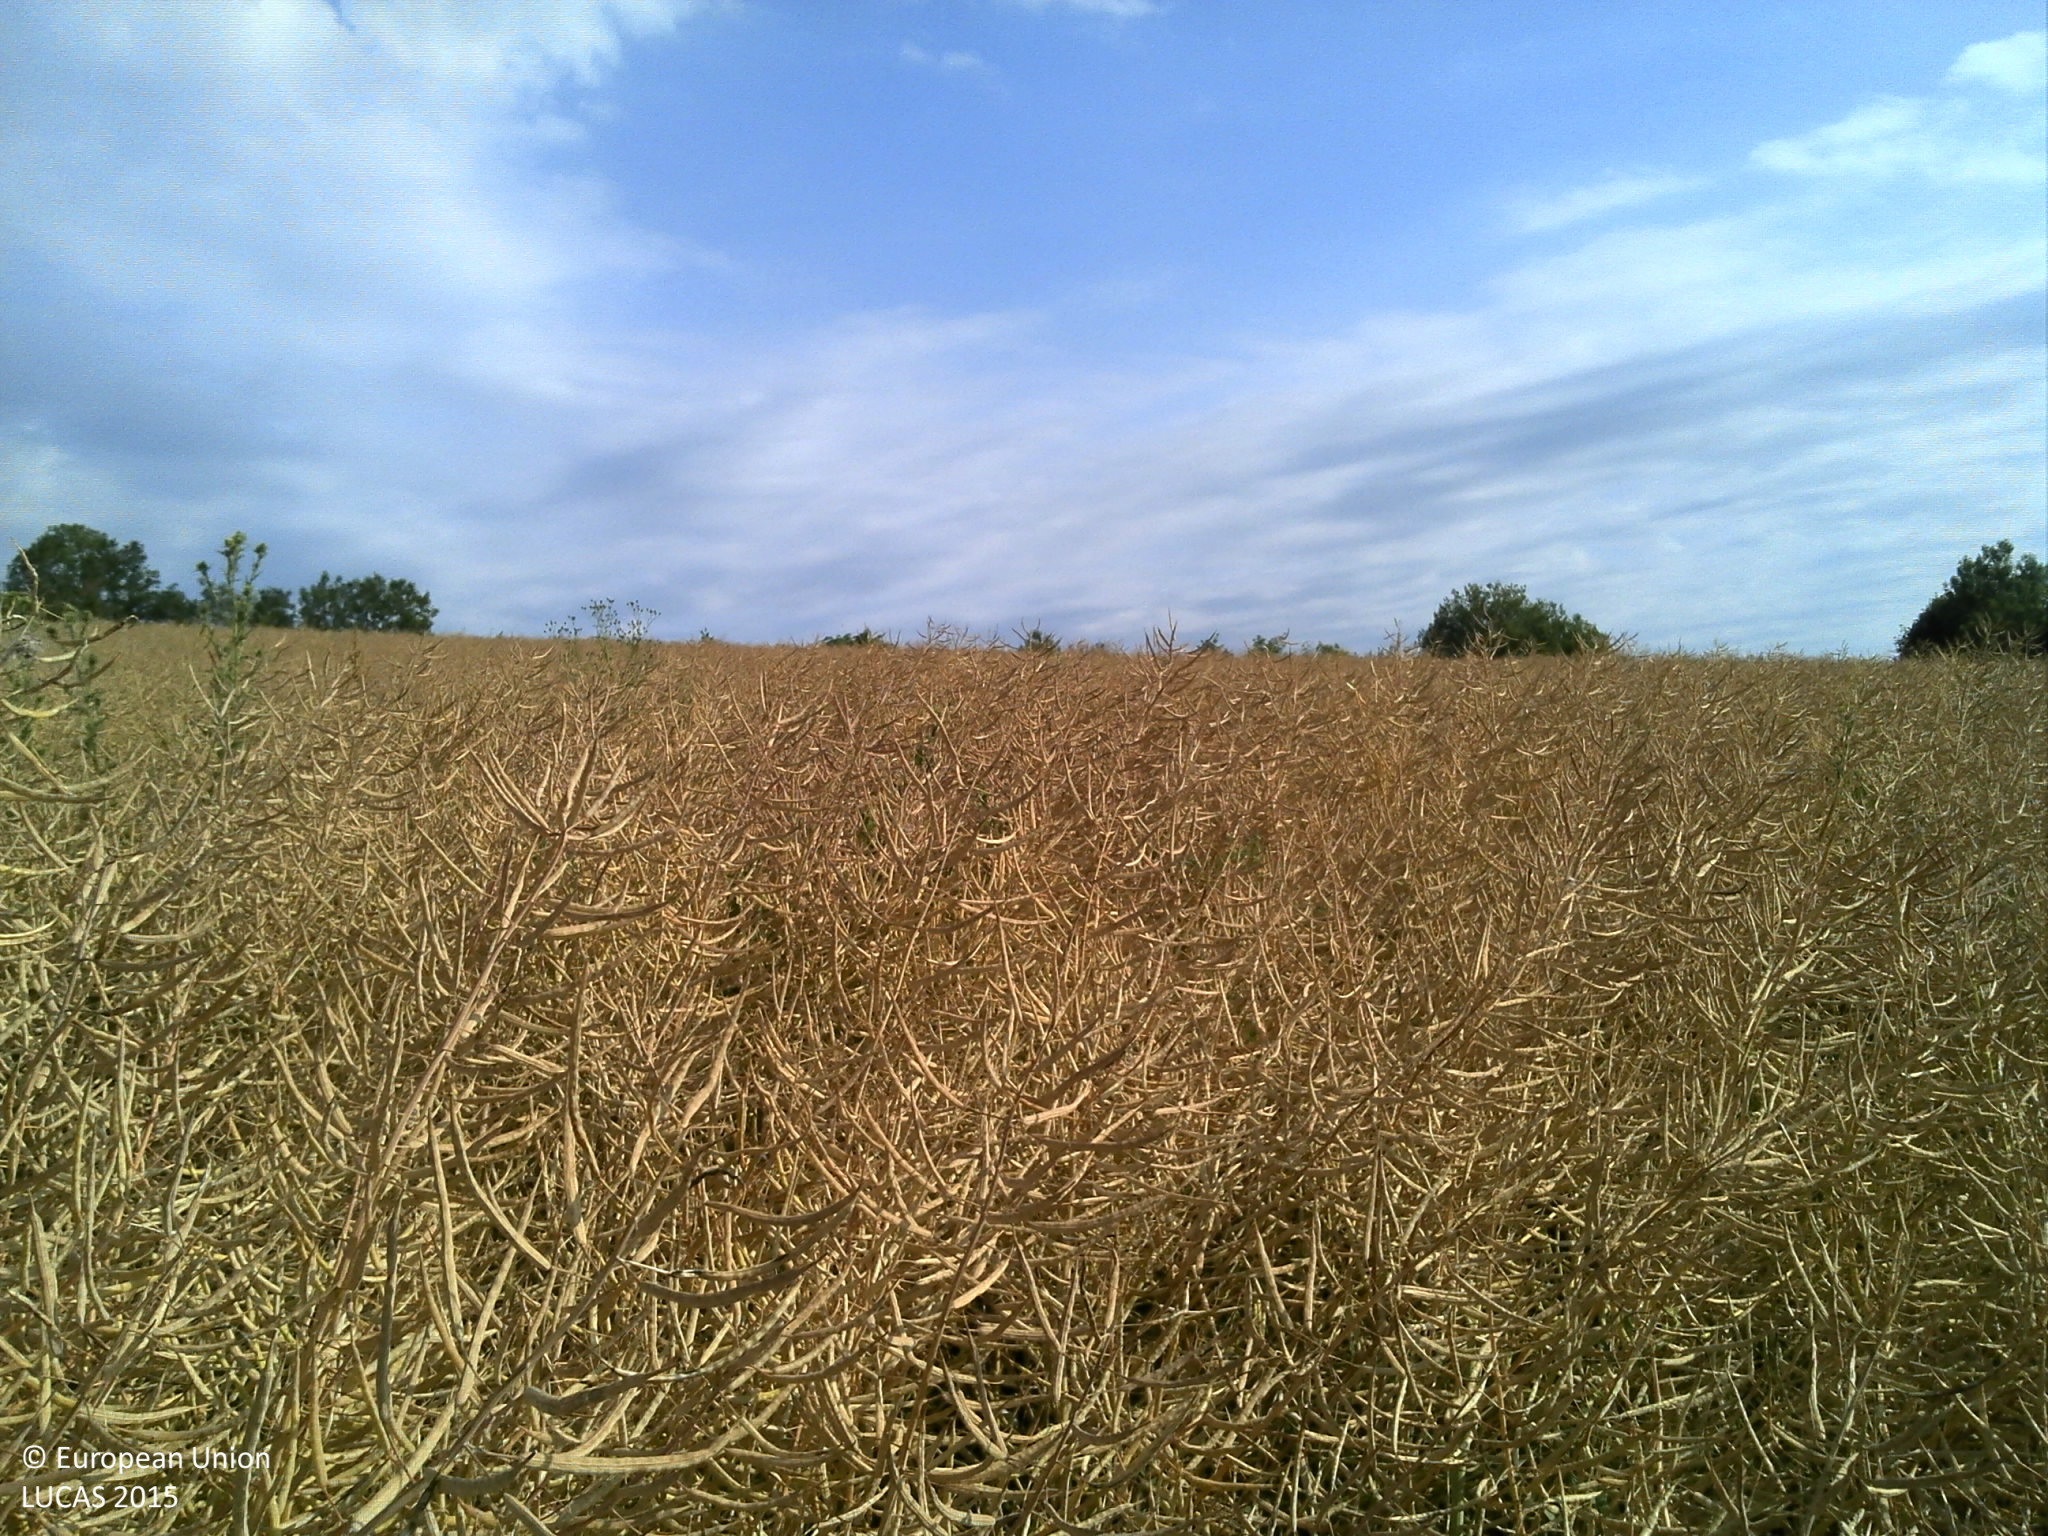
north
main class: Cropland
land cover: Rape and turnip rape
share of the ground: > 75 %
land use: Agriculture (excluding fallow land and kitchen gardens)
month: July
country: FR
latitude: 49.7000
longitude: 4.6865
